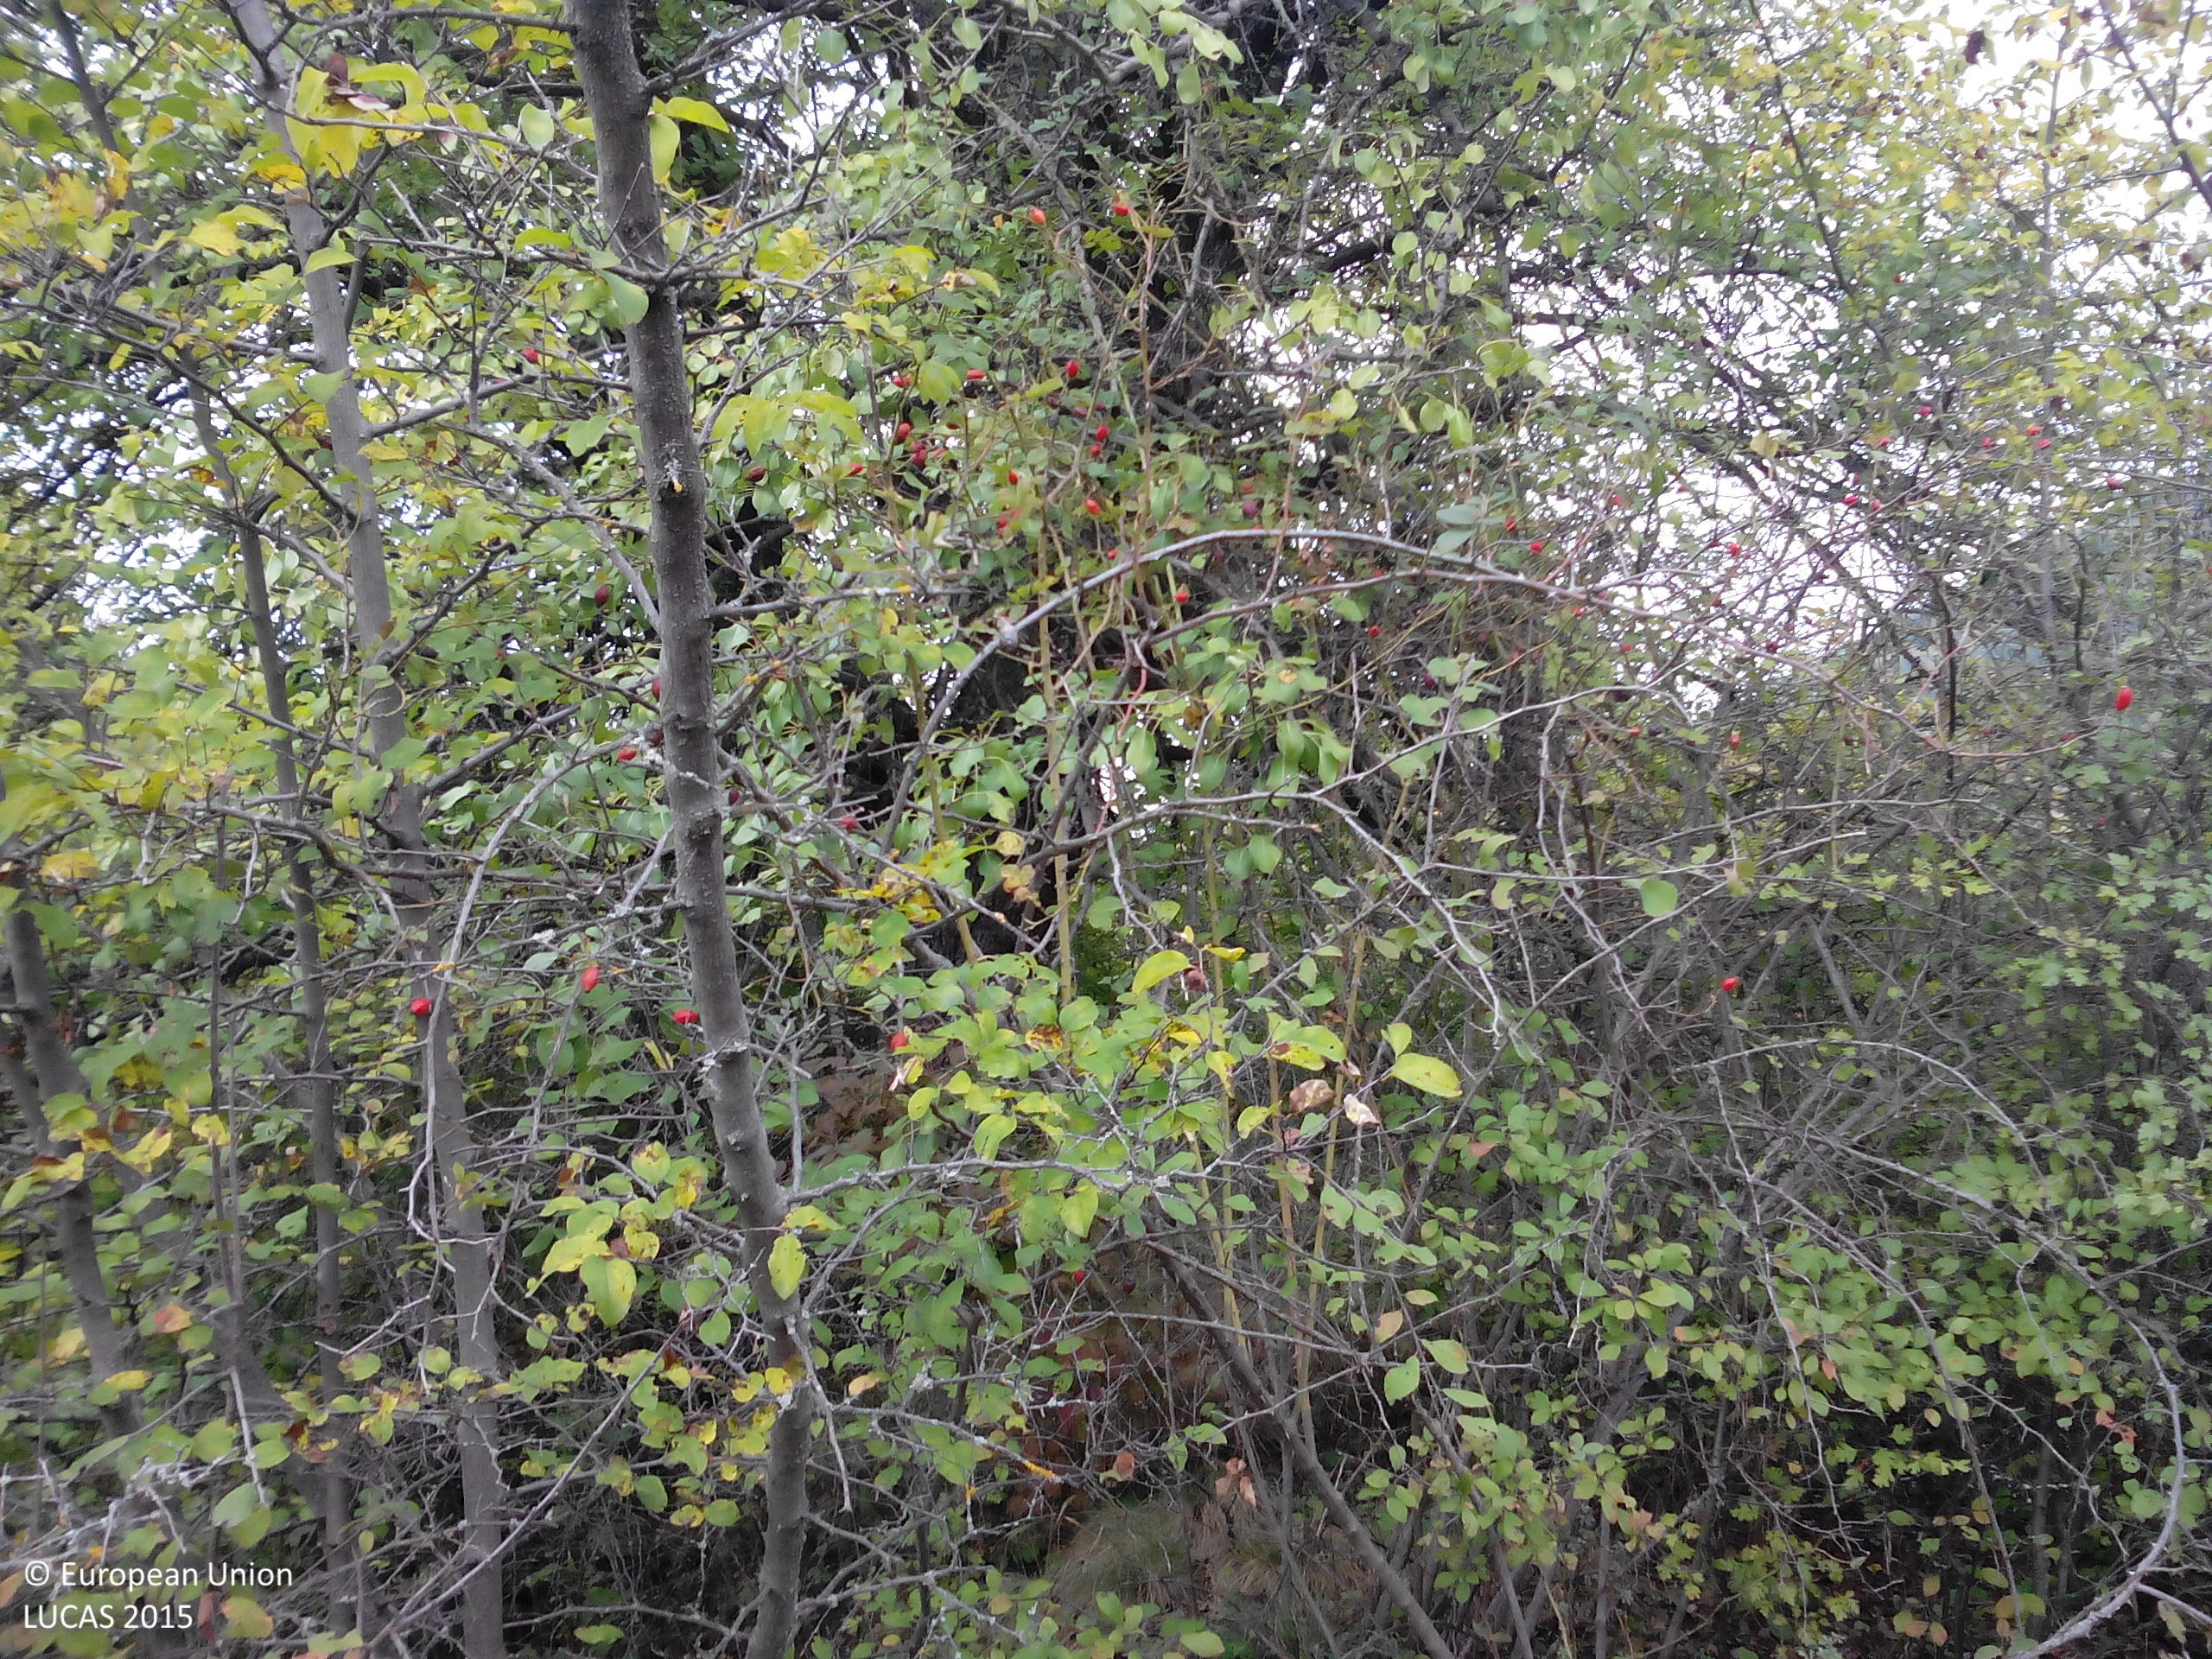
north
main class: Woodland
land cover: Broadleaved woodland
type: mesophytic deciduous forest
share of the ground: 50 - 75 %
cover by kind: broadleaved forest trees 70 %, shrubs 15 %, herbaceous plants 15 %
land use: Forestry
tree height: > 5 m
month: October
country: BG
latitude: 43.2423
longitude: 24.0536
